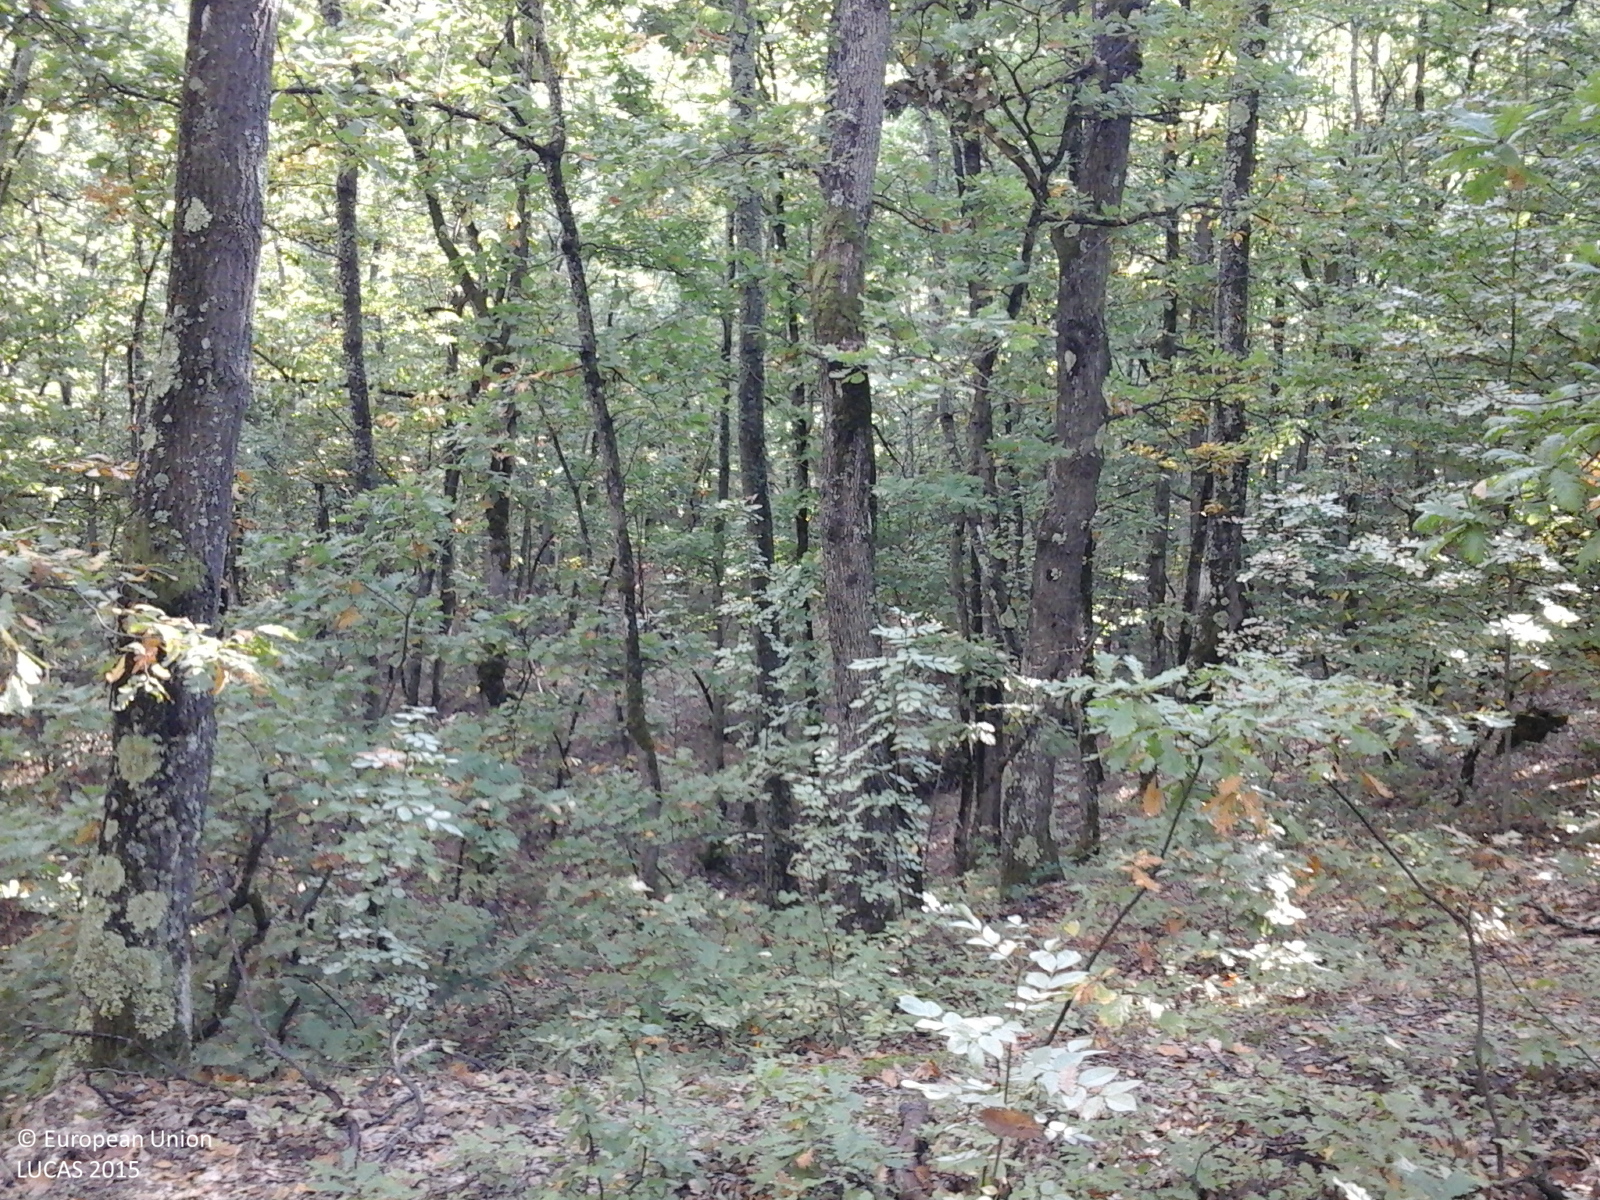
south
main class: Woodland
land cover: Broadleaved woodland
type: acidophilous oak and oak-birch forest
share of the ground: > 75 %
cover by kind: broadleaved forest trees 100 %
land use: Forestry
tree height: > 5 m
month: September
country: RO
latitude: 44.9859
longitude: 23.5912
